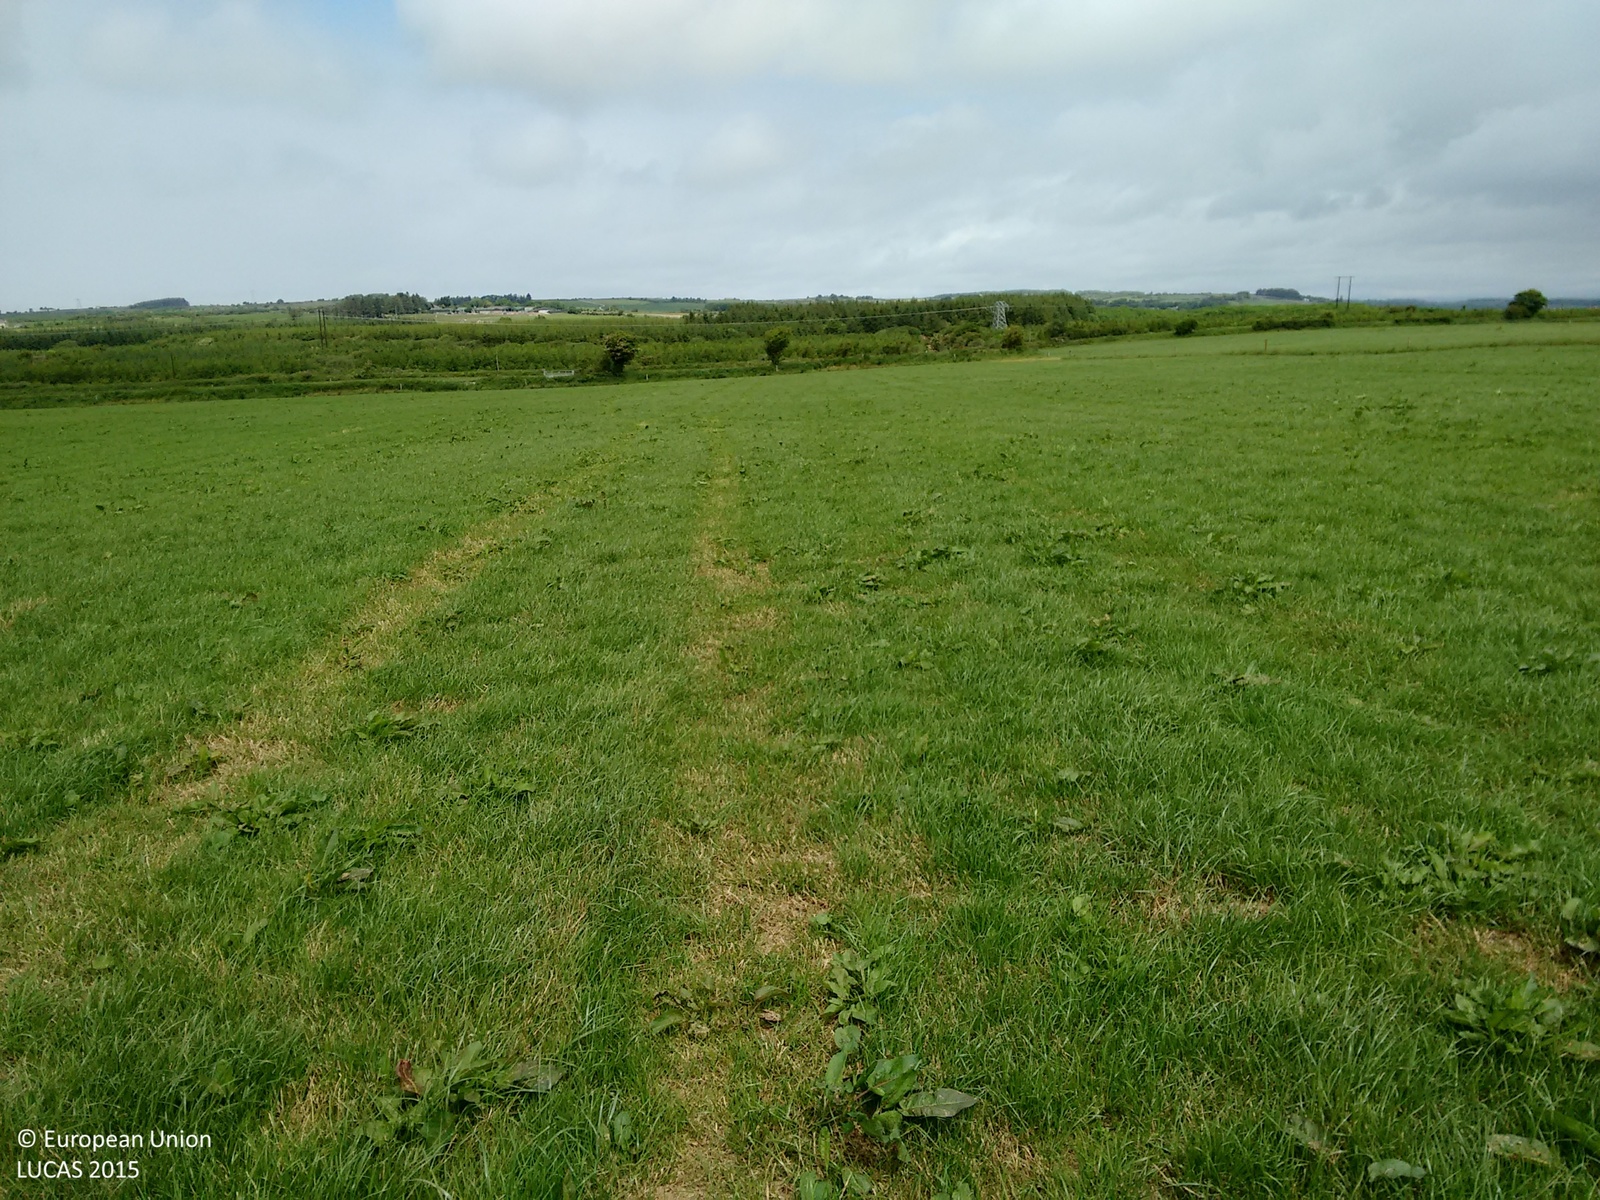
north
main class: Grassland
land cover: Grassland without tree/shrub cover
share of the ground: > 75 %
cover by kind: herbaceous plants 100 %
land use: Agriculture (excluding fallow land and kitchen gardens)
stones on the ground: < 10 %
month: June
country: IE
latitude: 52.1783
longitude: -7.3069
